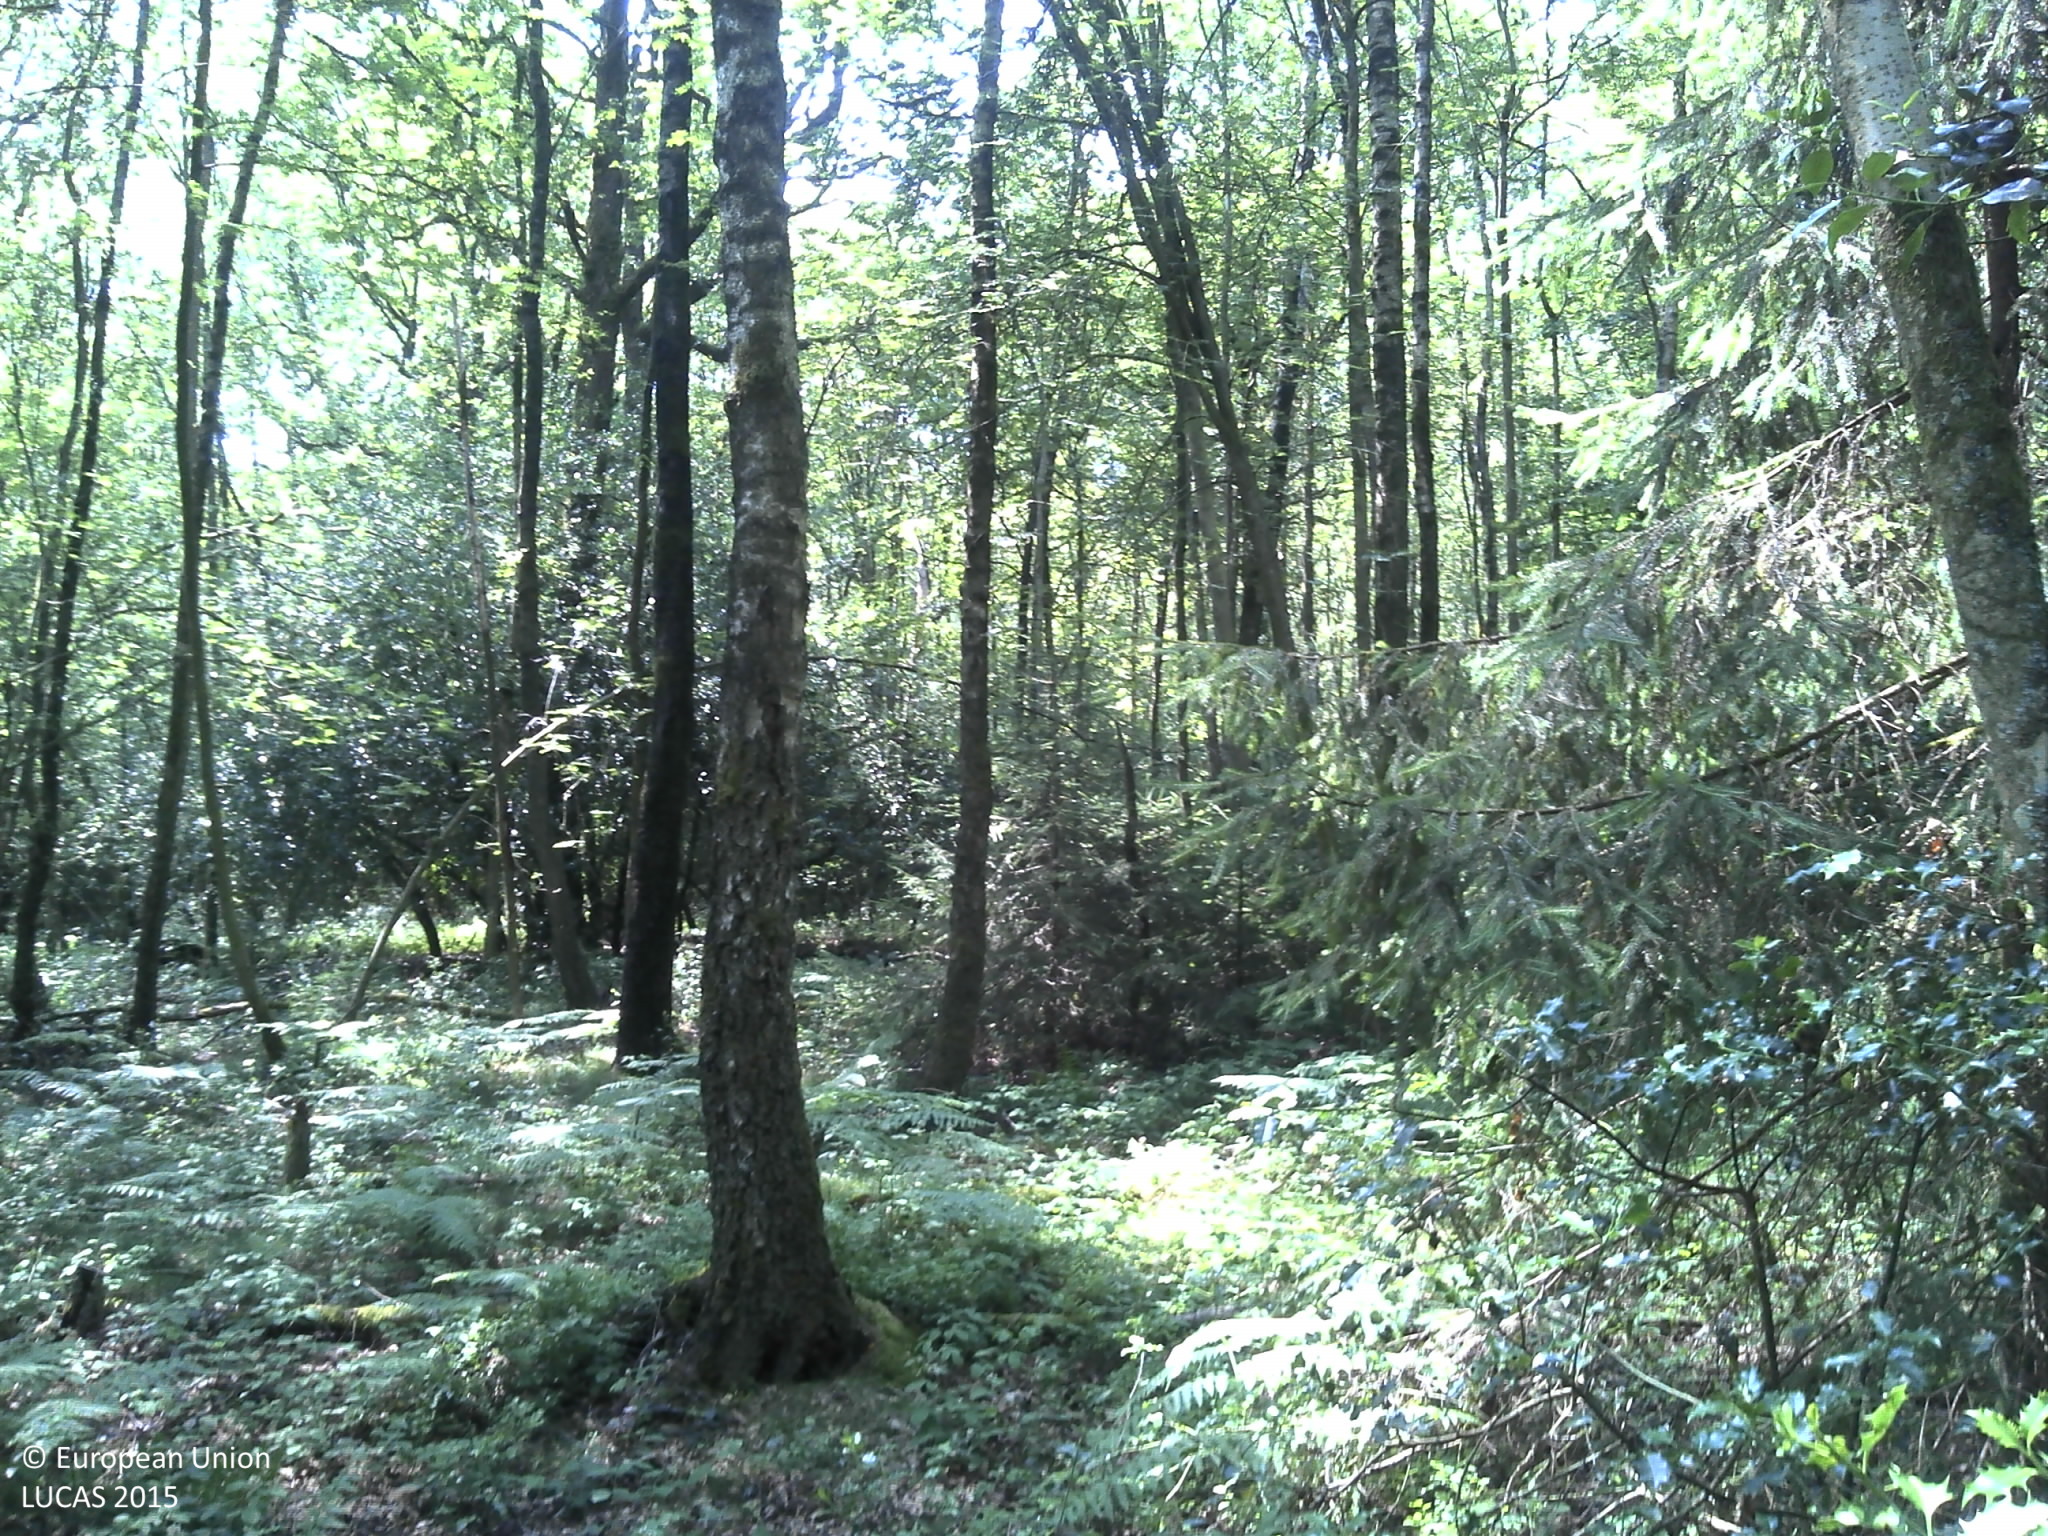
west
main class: Woodland
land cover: Broadleaved woodland
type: acidophilous oak and oak-birch forest
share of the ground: 50 - 75 %
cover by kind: broadleaved forest trees 60 %, herbaceous plants 20 %, coniferous forest trees 10 %, consolidated bare surface 10 %
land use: Forestry
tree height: > 5 m
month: July
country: FR
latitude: 49.9036
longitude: 4.8035
